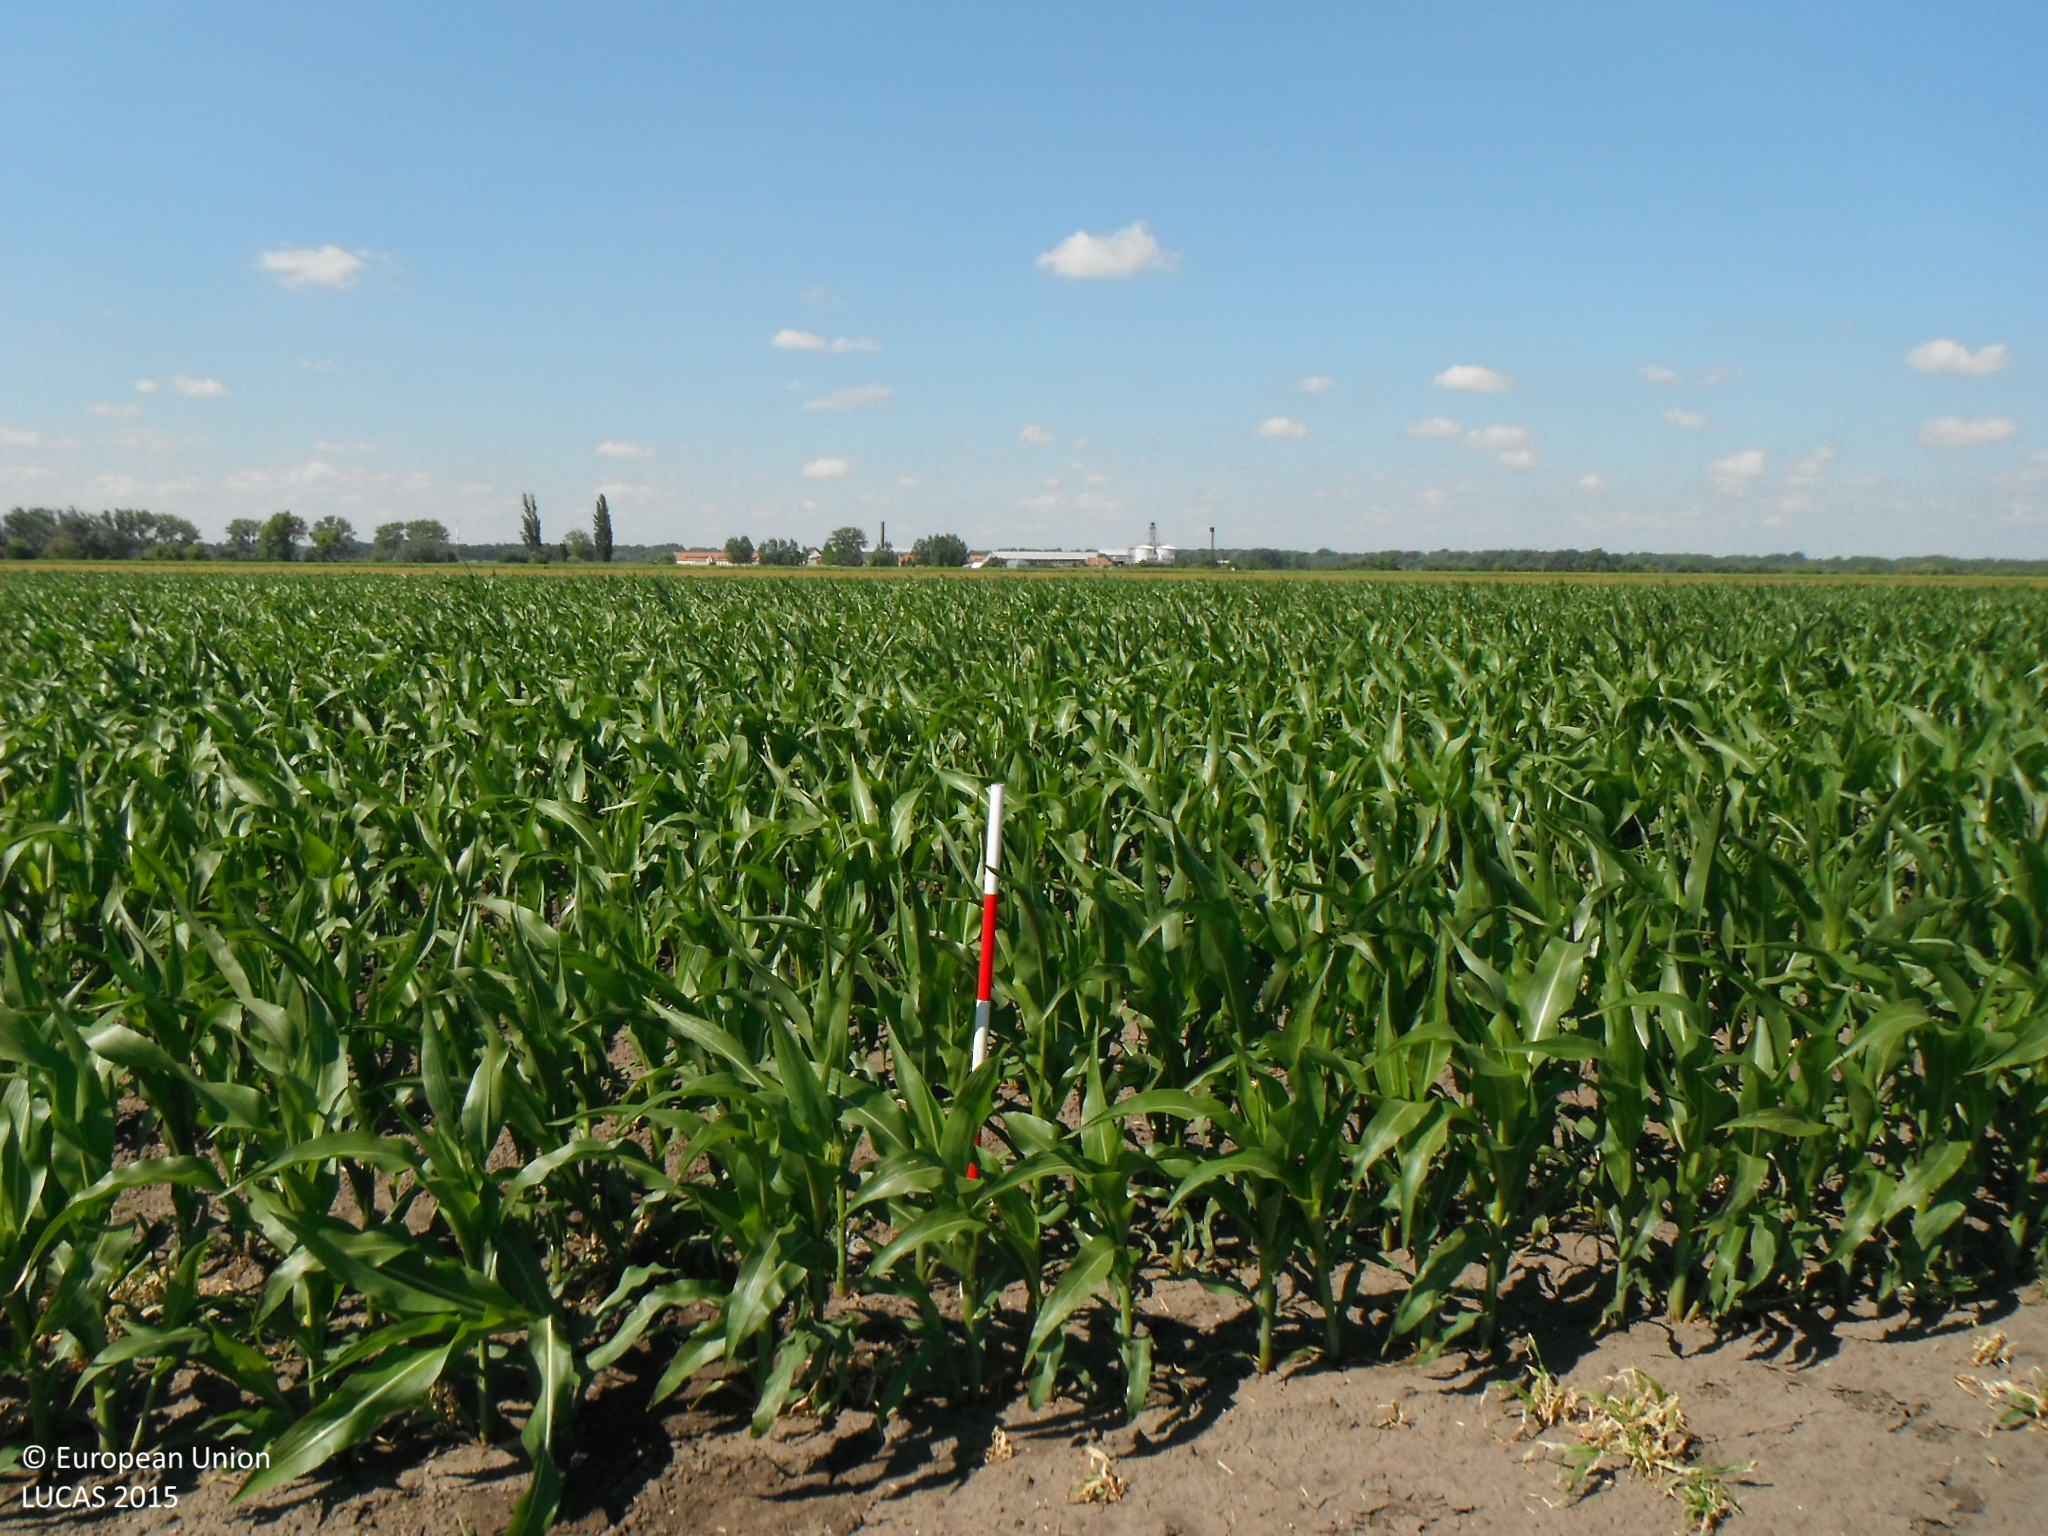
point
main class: Cropland
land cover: Maize
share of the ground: 50 - 75 %
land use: Agriculture (excluding fallow land and kitchen gardens)
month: June
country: SK
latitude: 47.7934
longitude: 18.1693
